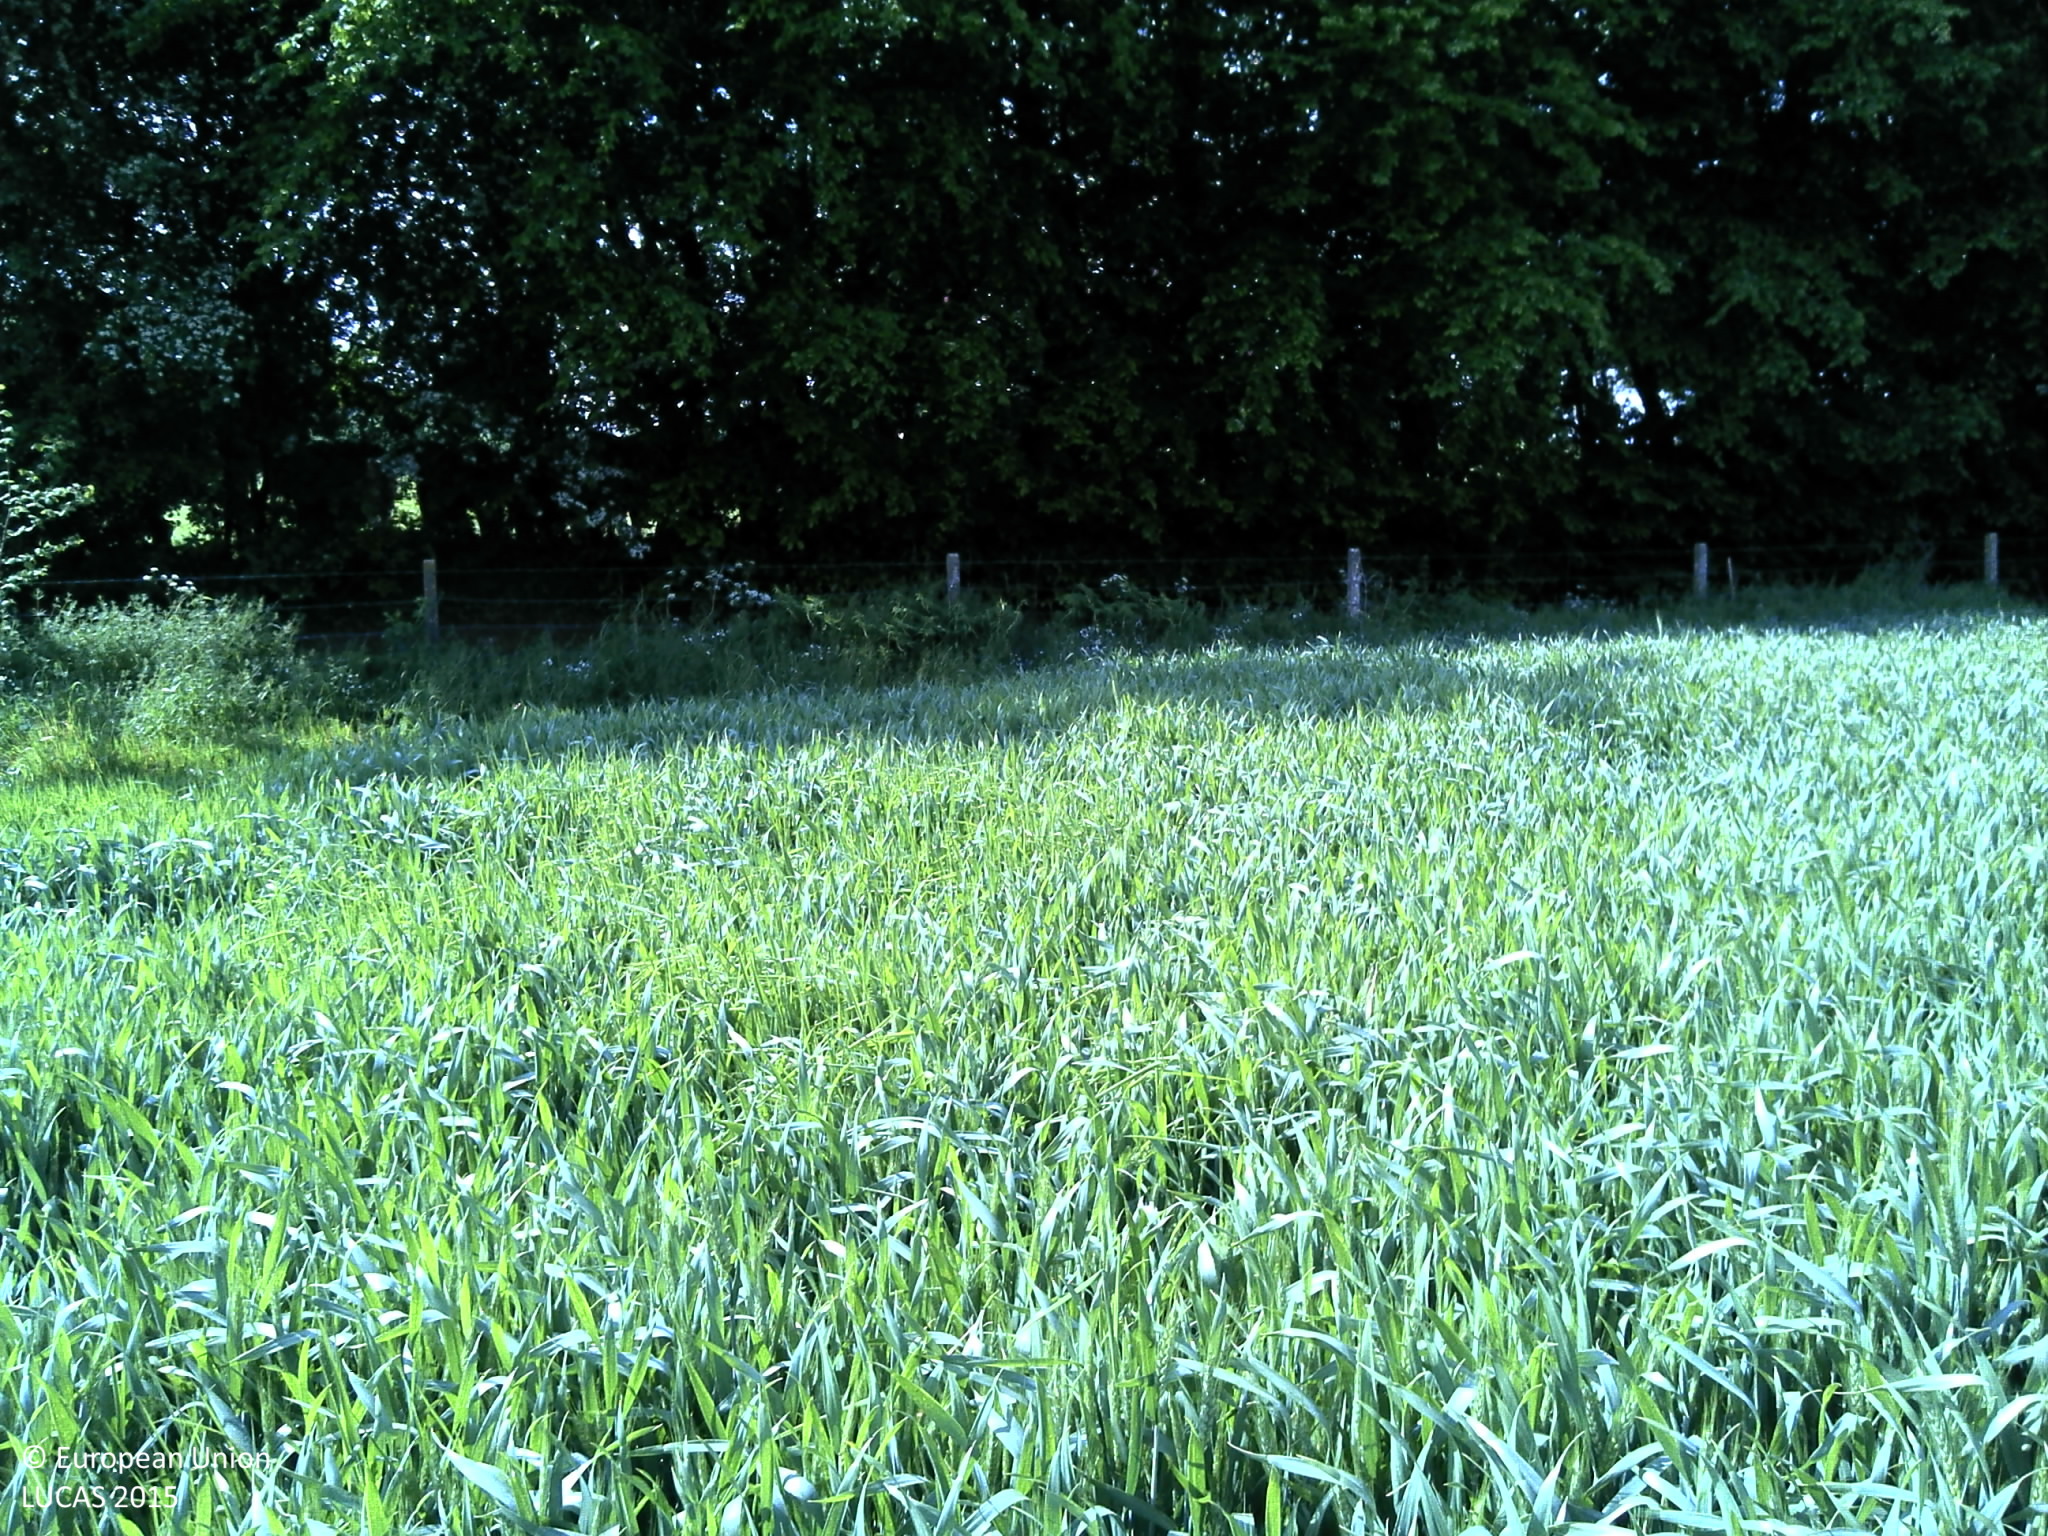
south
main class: Cropland
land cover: Durum wheat
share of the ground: > 75 %
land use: Agriculture (excluding fallow land and kitchen gardens)
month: May
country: FR
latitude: 49.6437
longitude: 0.9617
